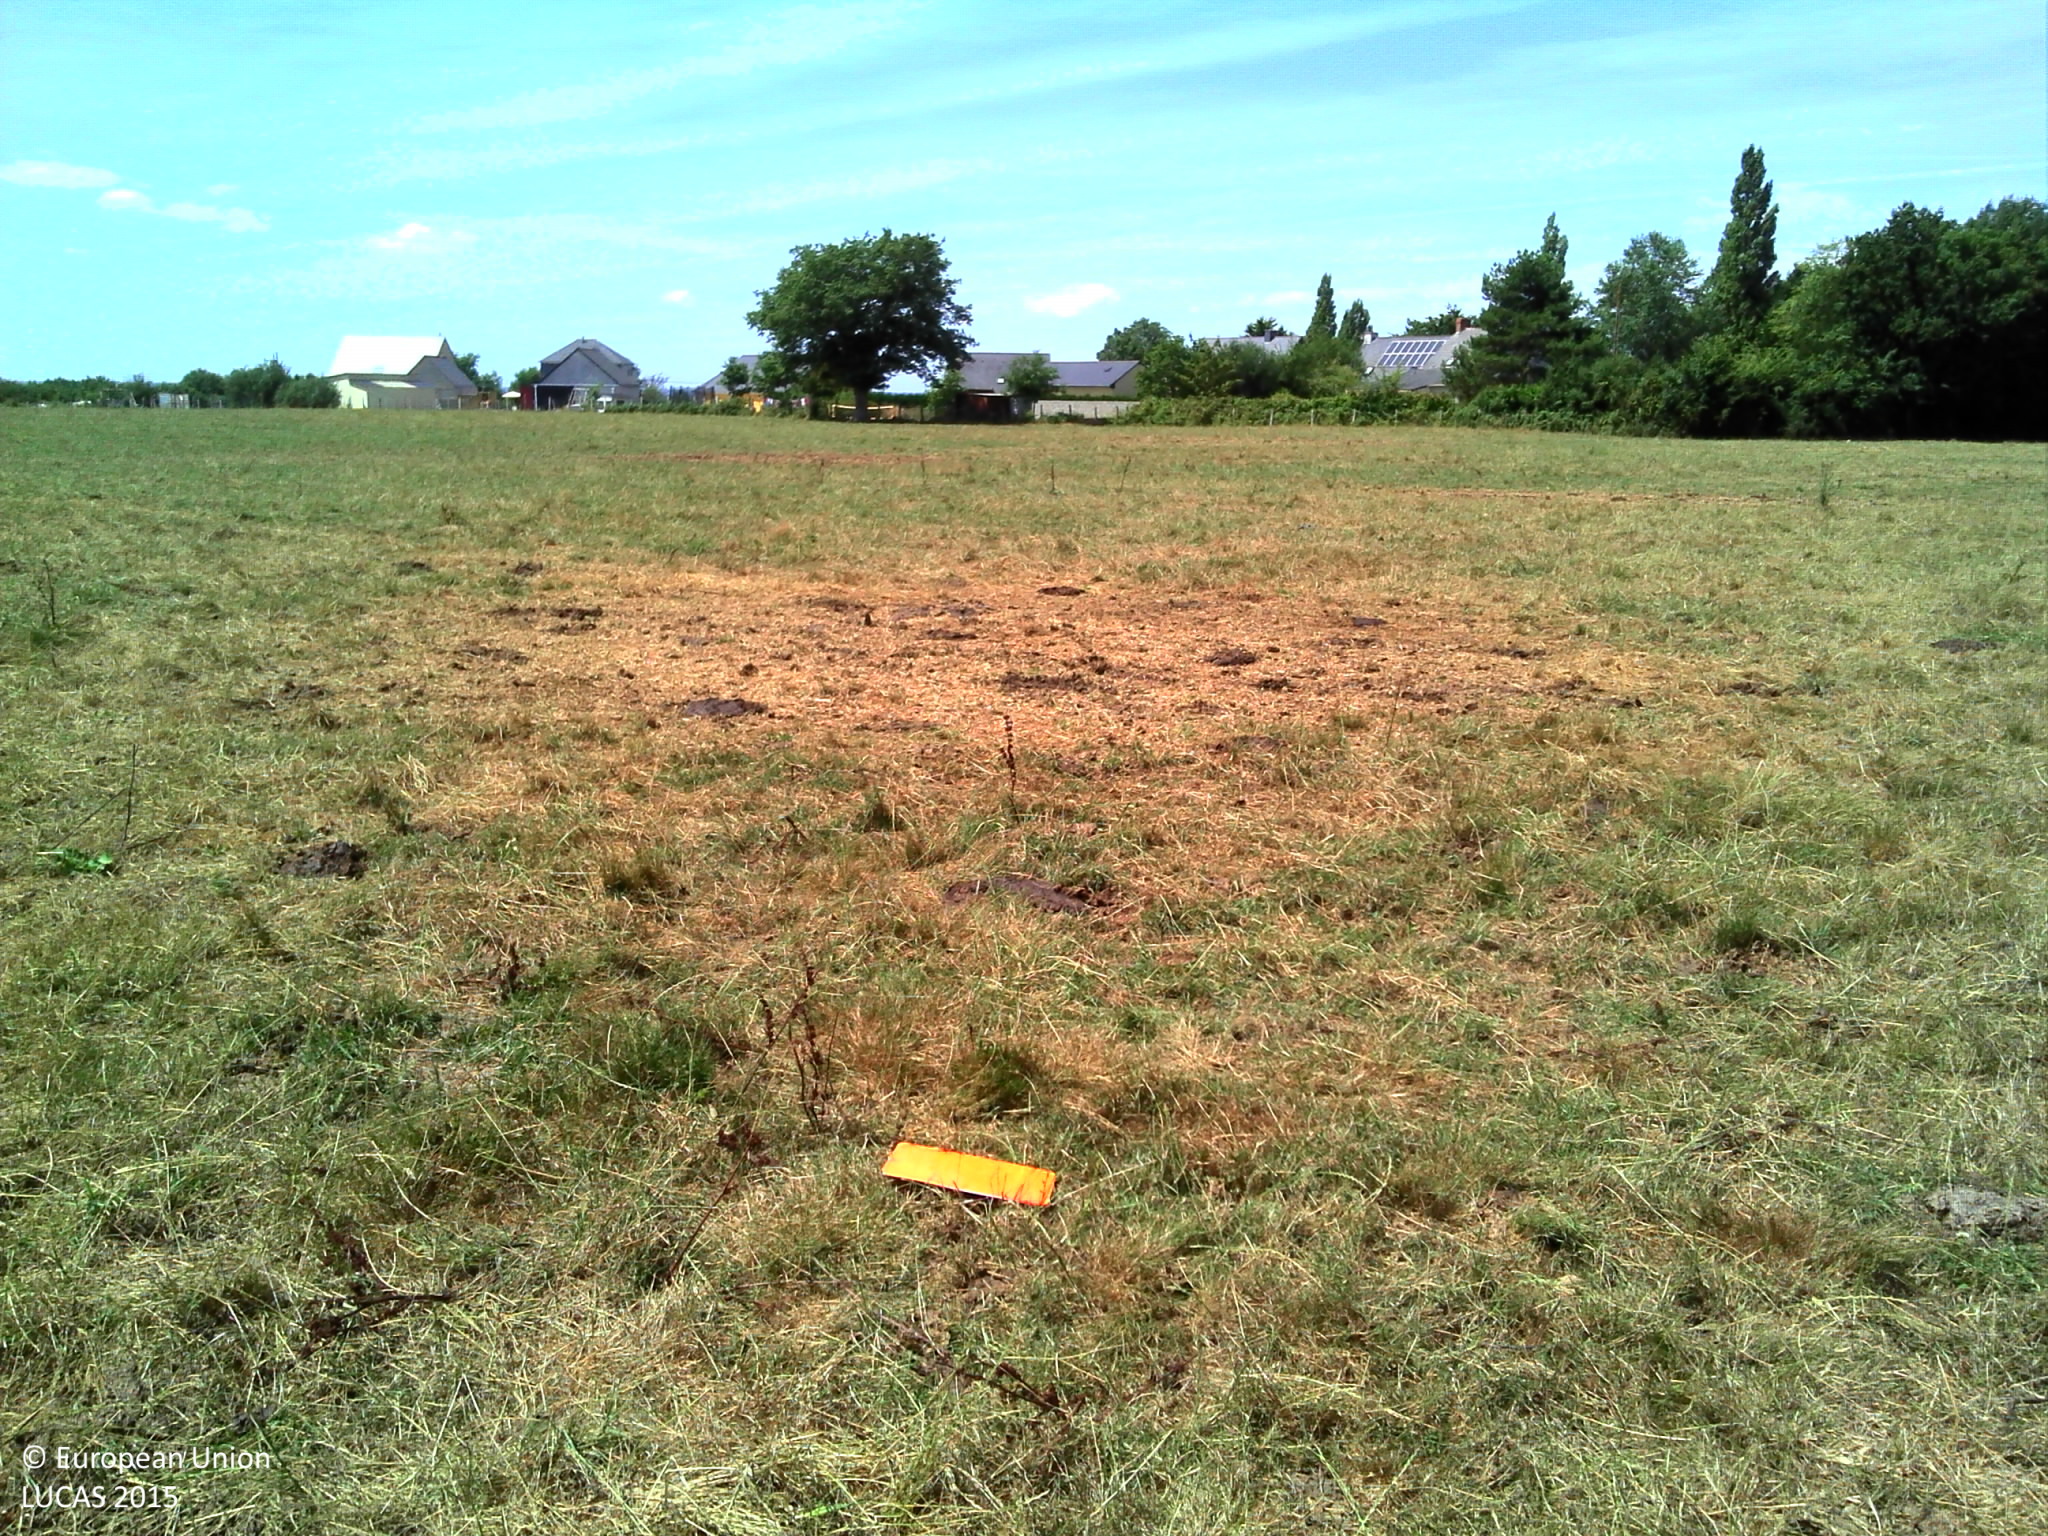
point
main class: Cropland
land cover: Temporary grasslands
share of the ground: > 75 %
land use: Agriculture (excluding fallow land and kitchen gardens)
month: July
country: FR
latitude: 47.4000
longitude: -2.0142
